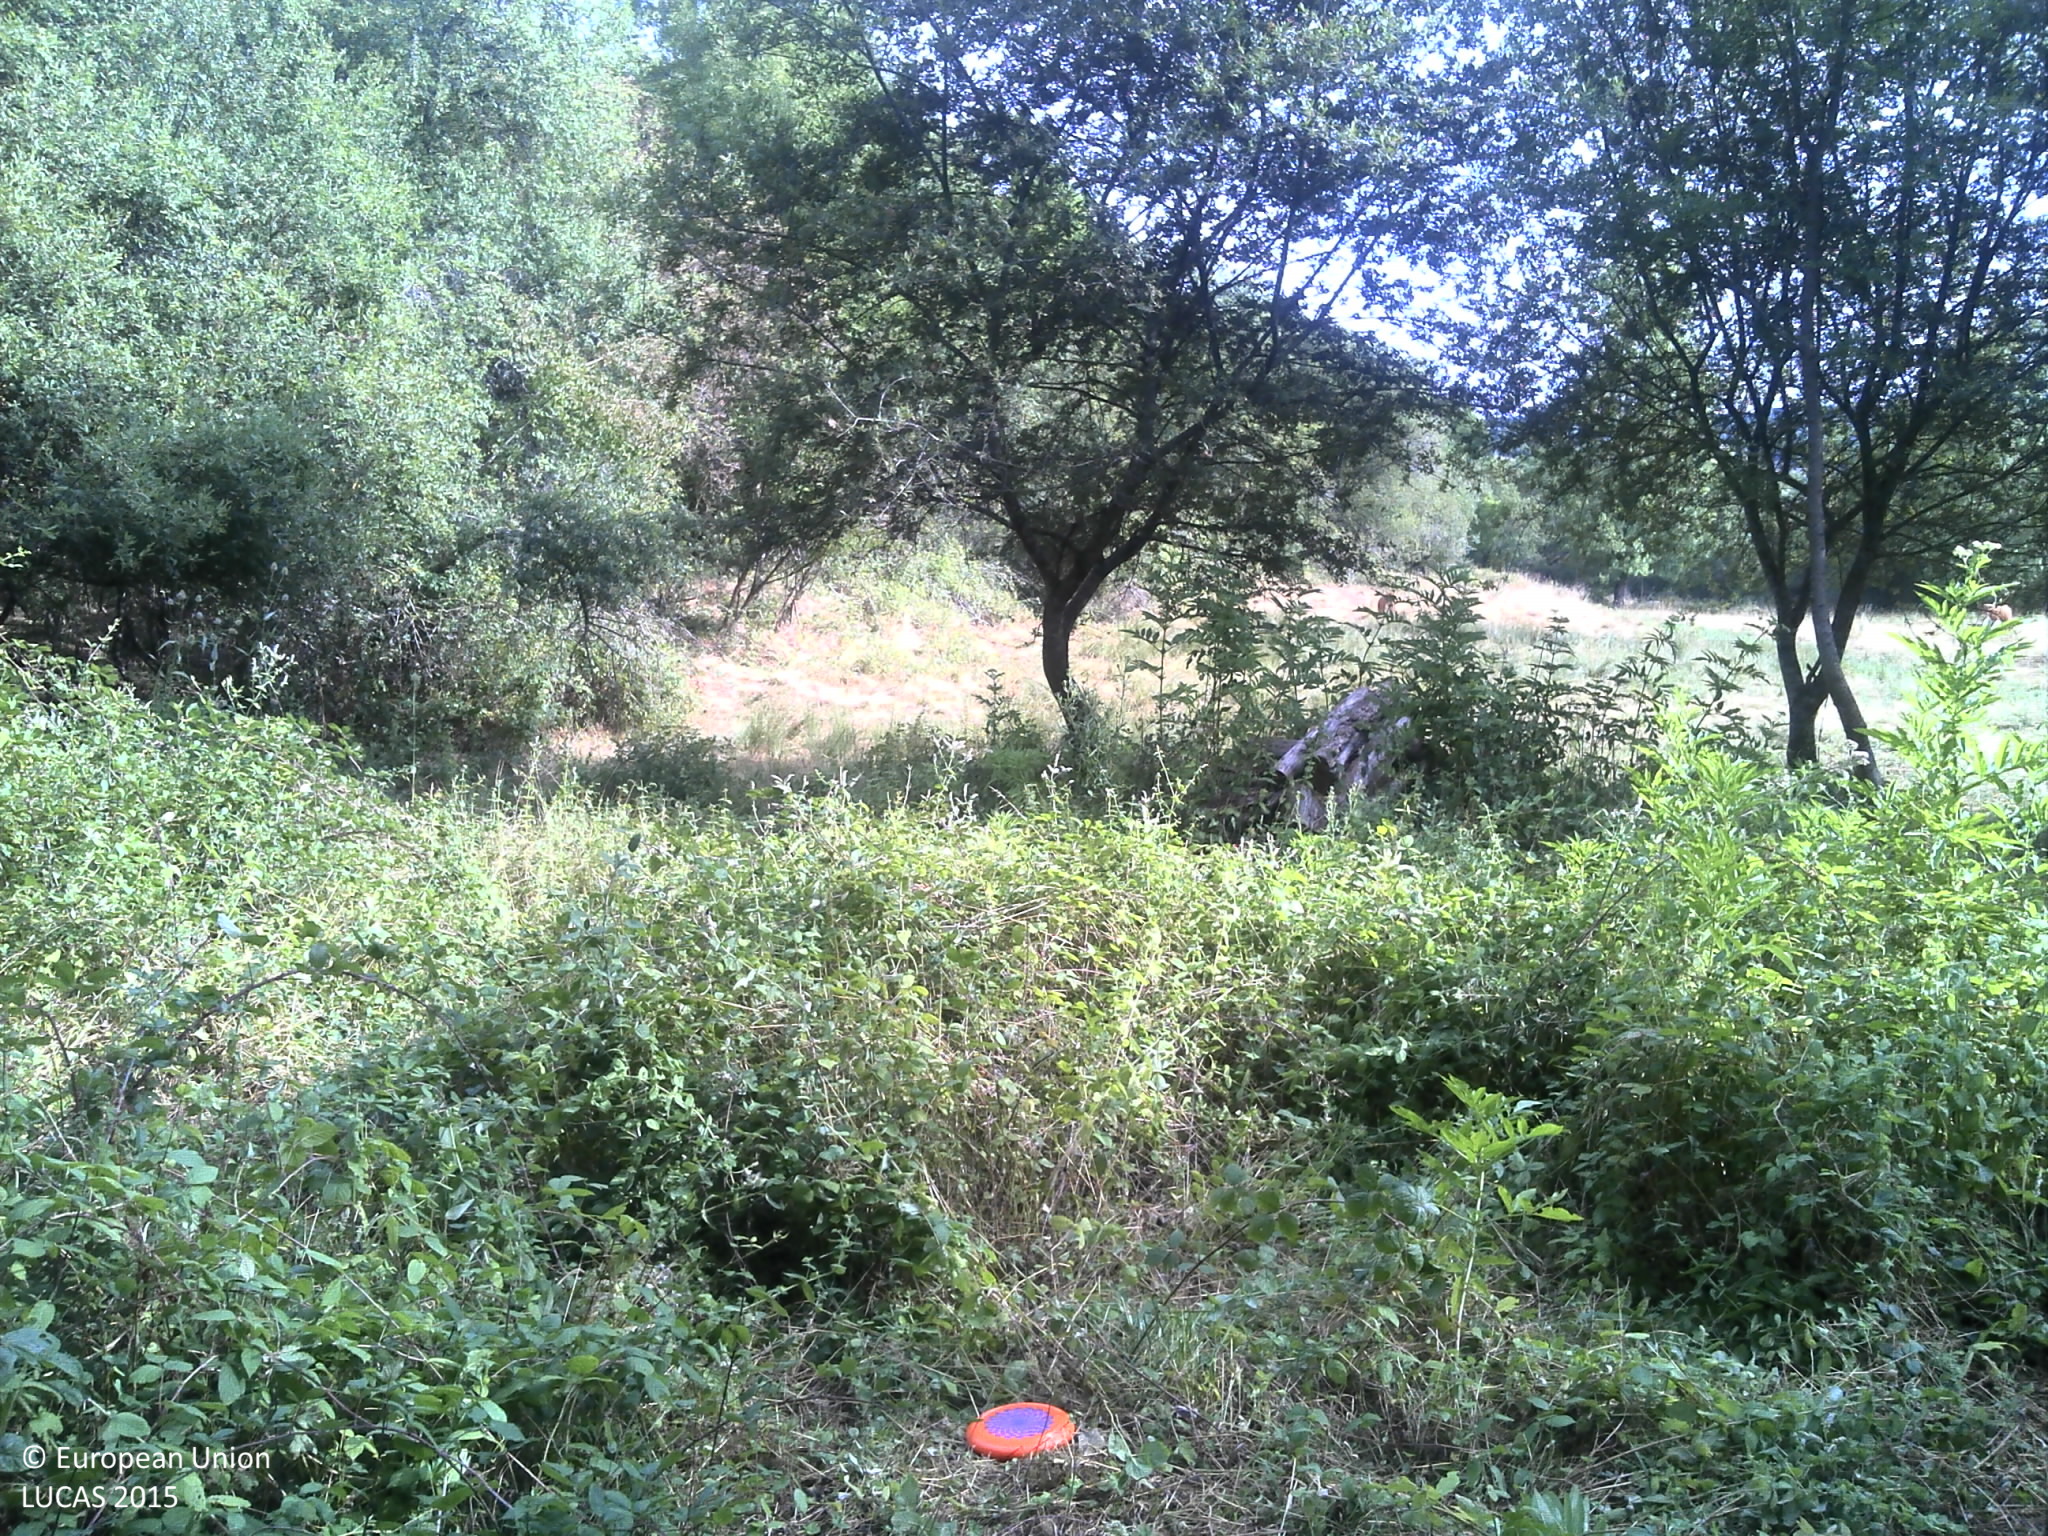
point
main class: Grassland
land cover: Spontaneously vegetated surfaces
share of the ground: > 75 %
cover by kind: herbaceous plants 100 %
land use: Agriculture (excluding fallow land and kitchen gardens)
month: July
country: FR
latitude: 45.0586
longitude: 1.5767
